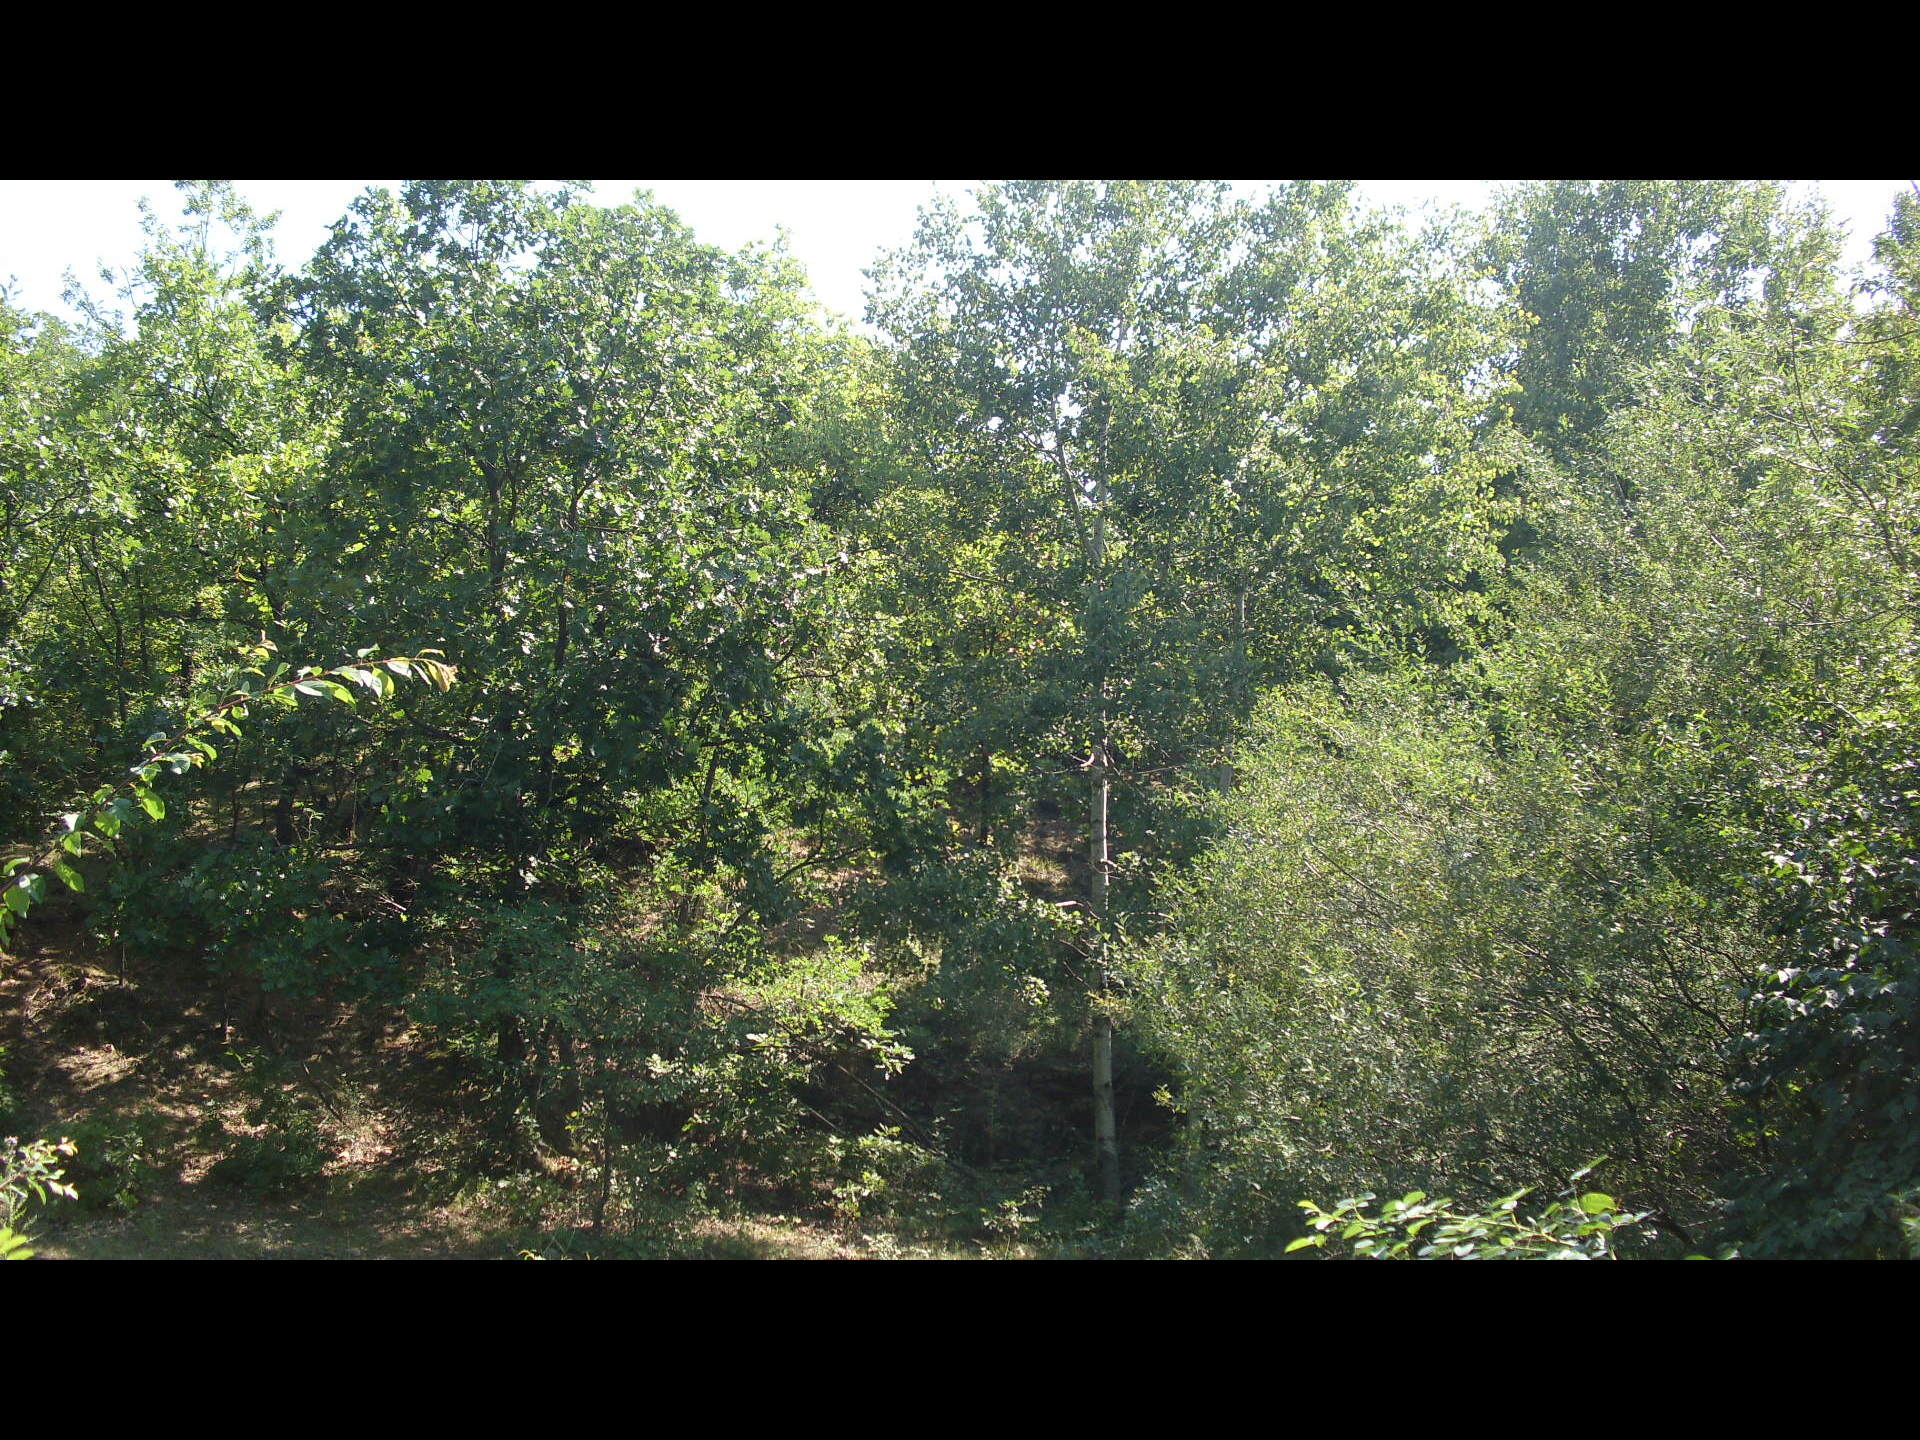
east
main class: Woodland
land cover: Broadleaved woodland
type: thermophilous deciduous forest
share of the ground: 50 - 75 %
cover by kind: broadleaved forest trees 60 %, shrubs 20 %, herbaceous plants 20 %
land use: Forestry
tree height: < 5 m
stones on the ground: < 10 %
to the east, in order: Broadleaved woodland; Rivers and streams; Grassland without tree/shrub cover; Broadleaved woodland; Tracks; Broadleaved woodland; Ditches and canals; Broadleaved woodland; Tracks; Broadleaved woodland; Tracks; Broadleaved woodland; Tracks; Broadleaved woodland
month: August
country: BG
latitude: 43.4912
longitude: 23.0088
